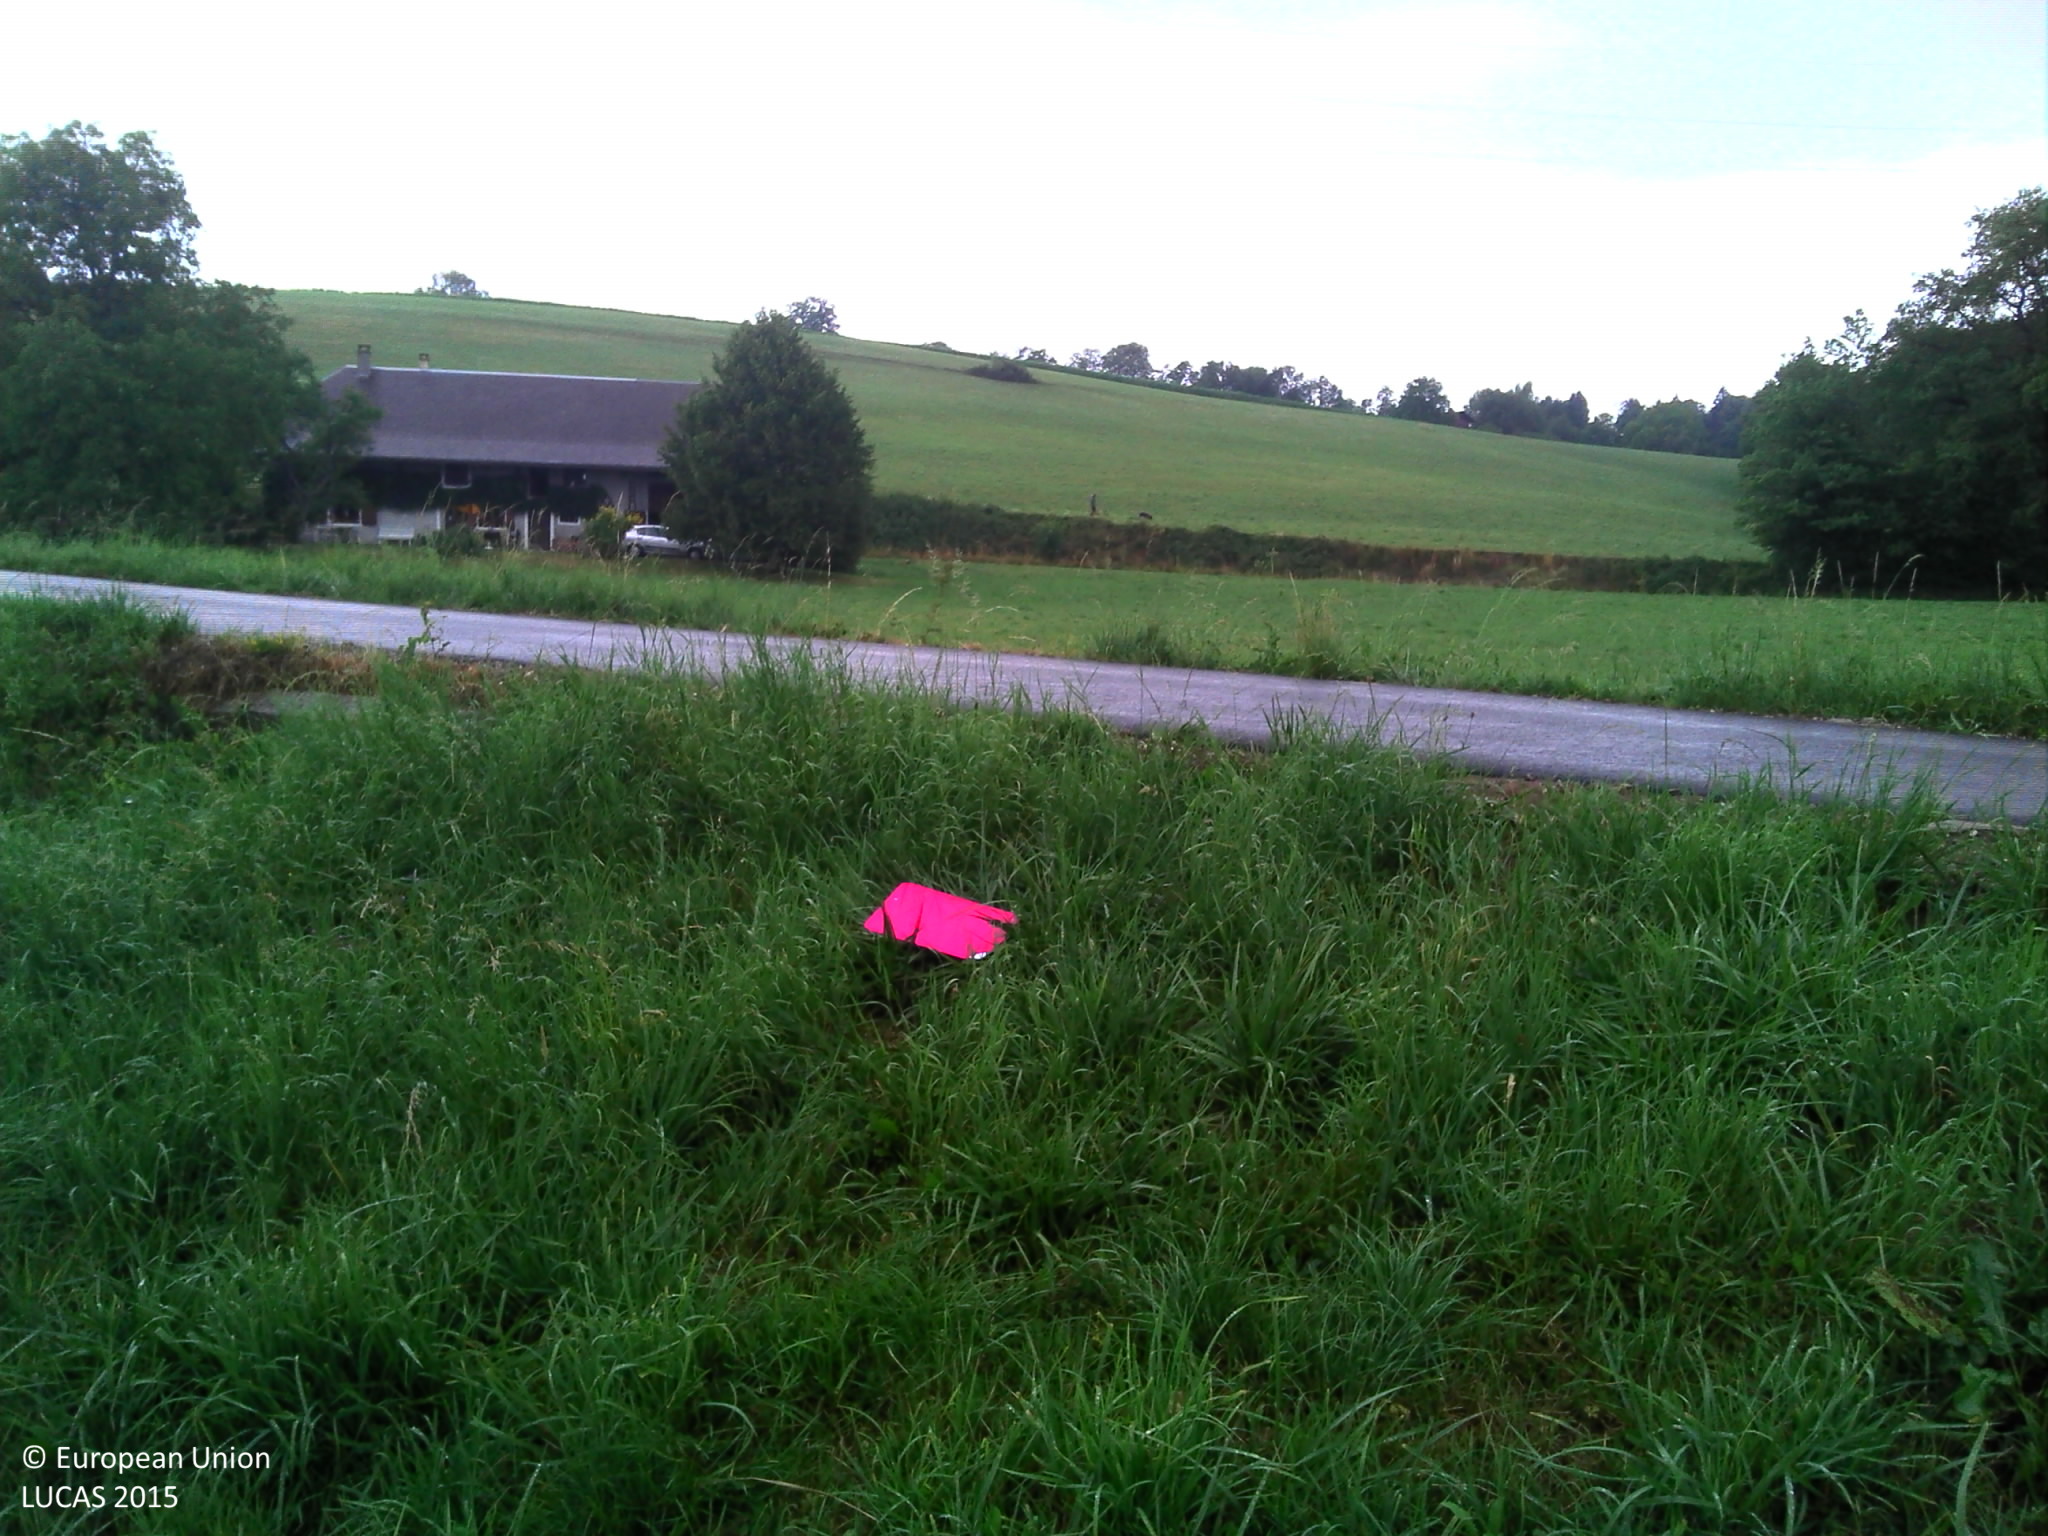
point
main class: Grassland
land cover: Grassland without tree/shrub cover
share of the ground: > 75 %
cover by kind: herbaceous plants 100 %
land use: Agriculture (excluding fallow land and kitchen gardens)
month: July
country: FR
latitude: 46.0490
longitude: 6.1912
